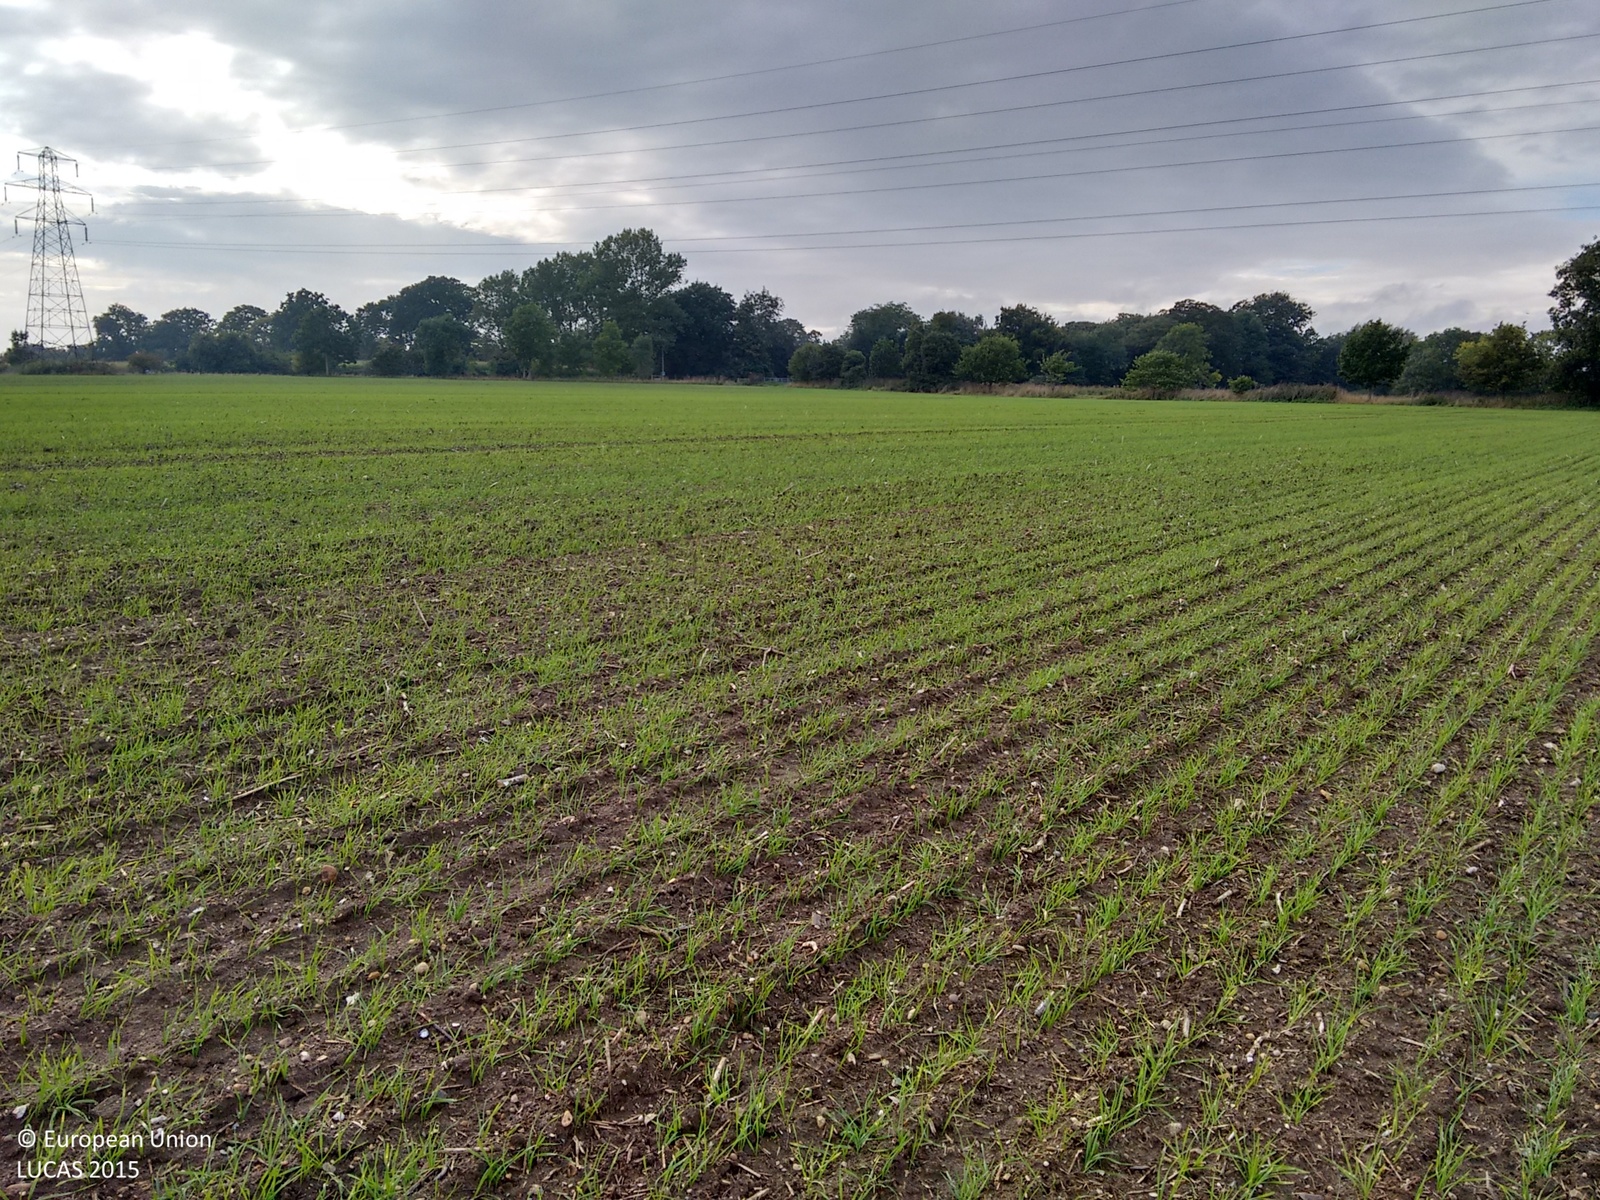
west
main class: Cropland
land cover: Common wheat
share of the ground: 10 - 25 %
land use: Agriculture (excluding fallow land and kitchen gardens)
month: October
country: GB
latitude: 52.4533
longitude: 1.5198
